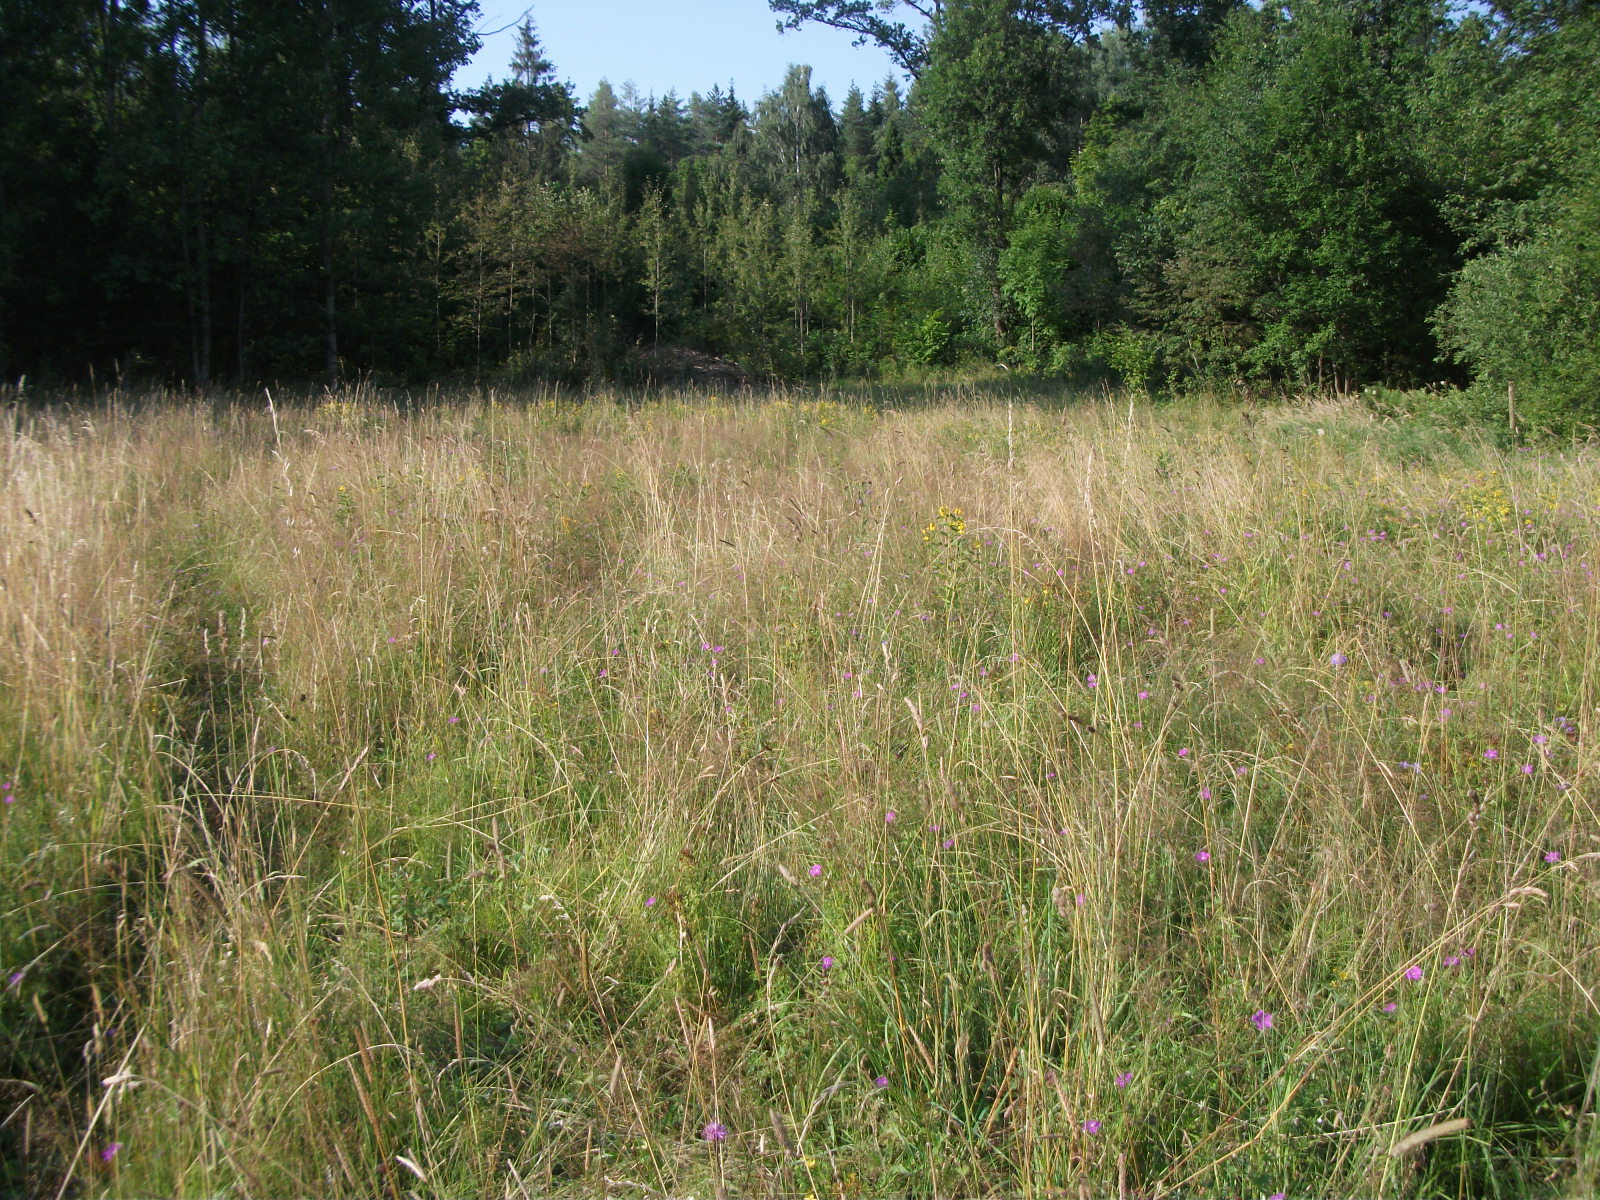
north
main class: Grassland
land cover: Grassland without tree/shrub cover
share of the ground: > 75 %
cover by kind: herbaceous plants 100 %
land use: Agriculture (excluding fallow land and kitchen gardens)
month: August
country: LV
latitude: 56.7926
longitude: 25.6933
